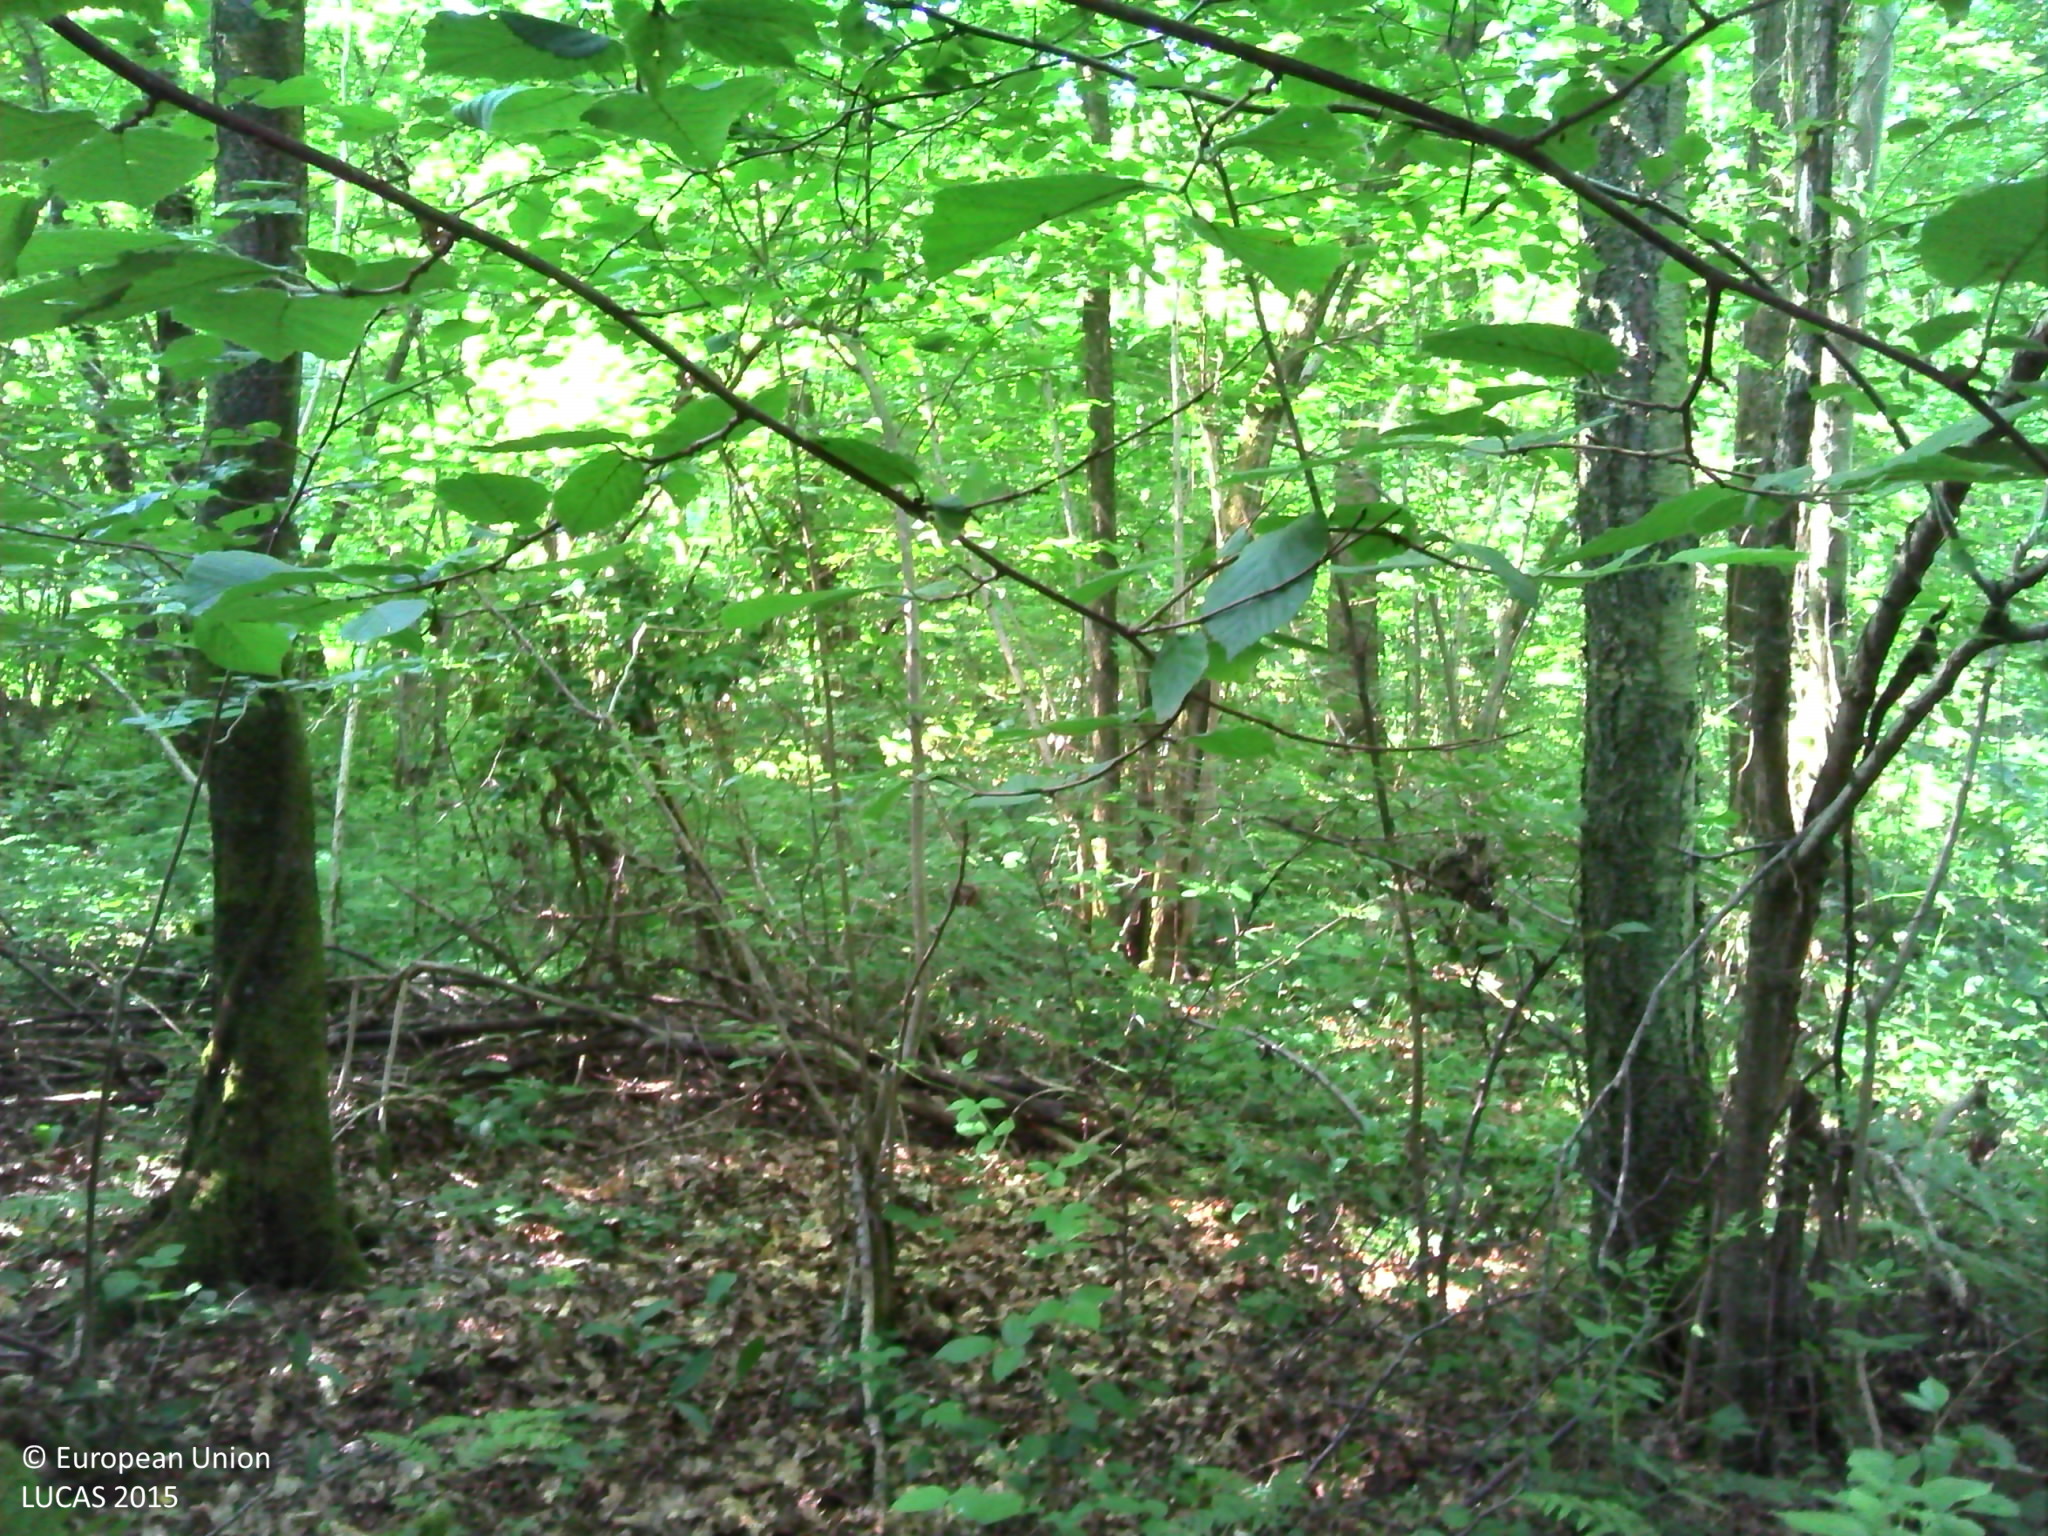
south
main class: Woodland
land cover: Broadleaved woodland
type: acidophilous oak and oak-birch forest
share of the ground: > 75 %
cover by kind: broadleaved forest trees 100 %
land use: Forestry
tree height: > 5 m
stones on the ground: < 10 %
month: July
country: BE
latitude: 50.2903
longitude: 4.5923
